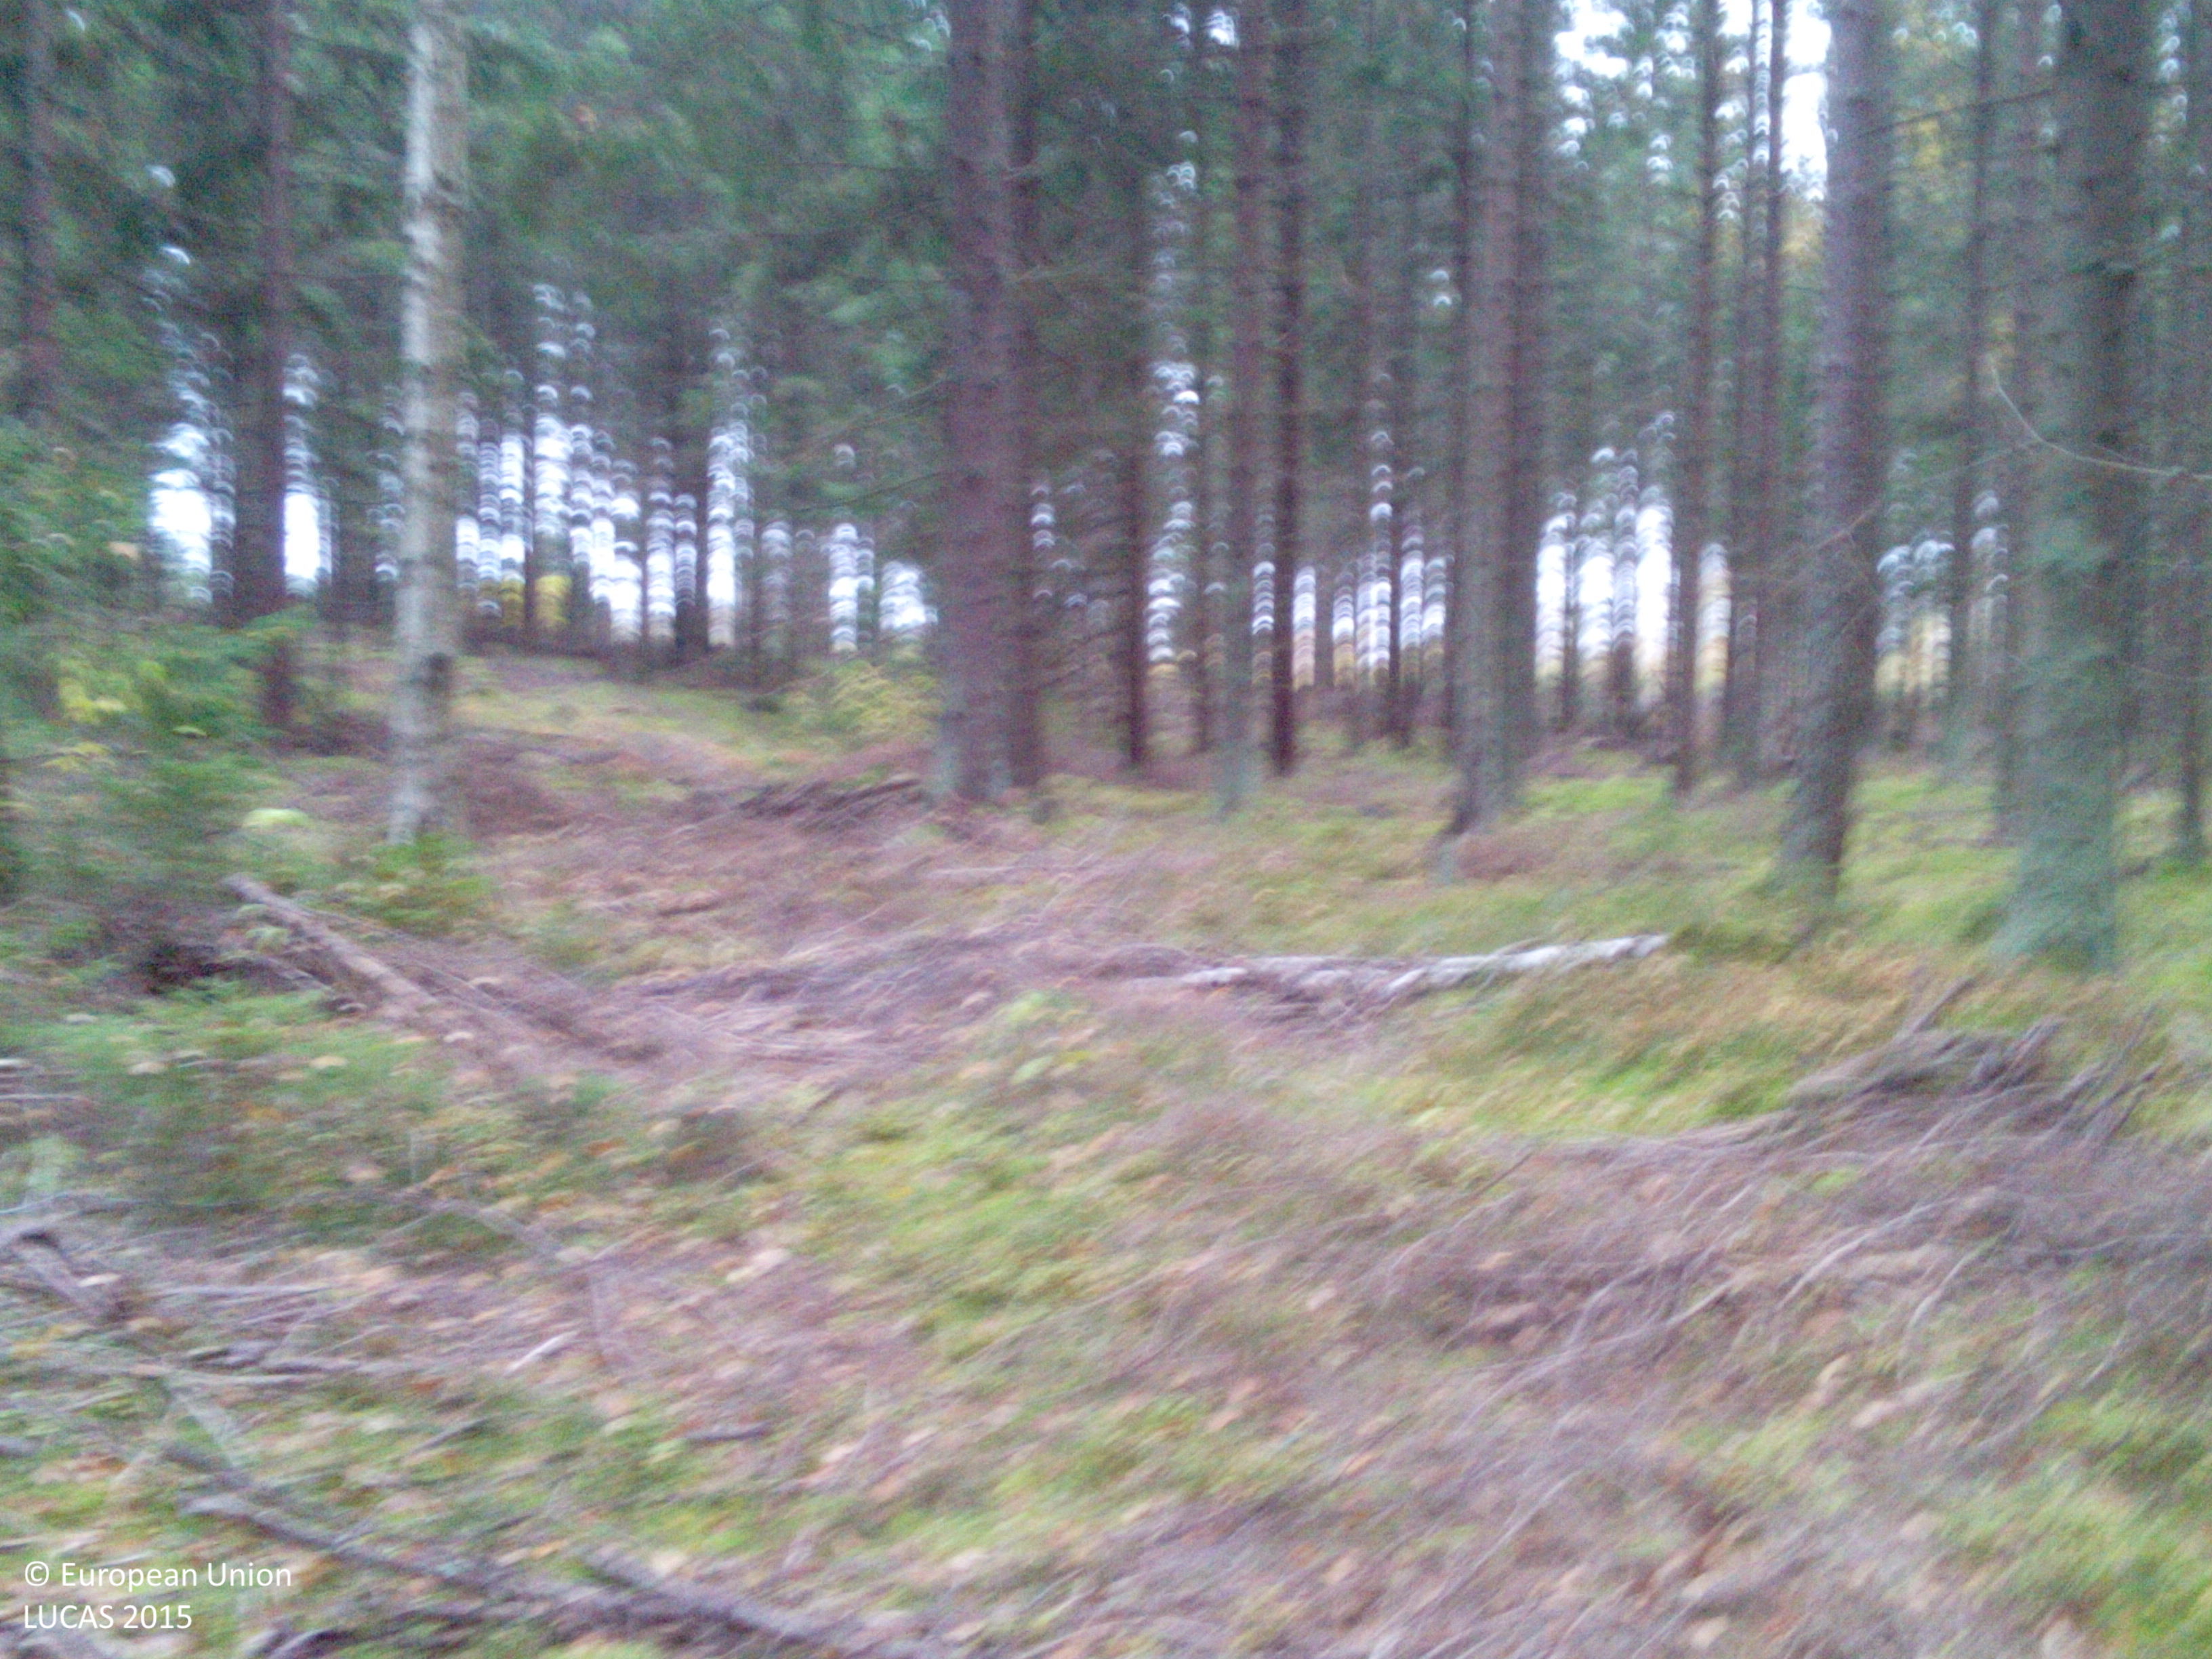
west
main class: Woodland
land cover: Spruce dominated coniferous woodland
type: boreal forest
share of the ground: > 75 %
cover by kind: coniferous forest trees 75 %, lichens and mosses 15 %, broadleaved forest trees 10 %
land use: Forestry
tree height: > 5 m
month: October
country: SE
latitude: 59.0699
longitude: 16.1856
